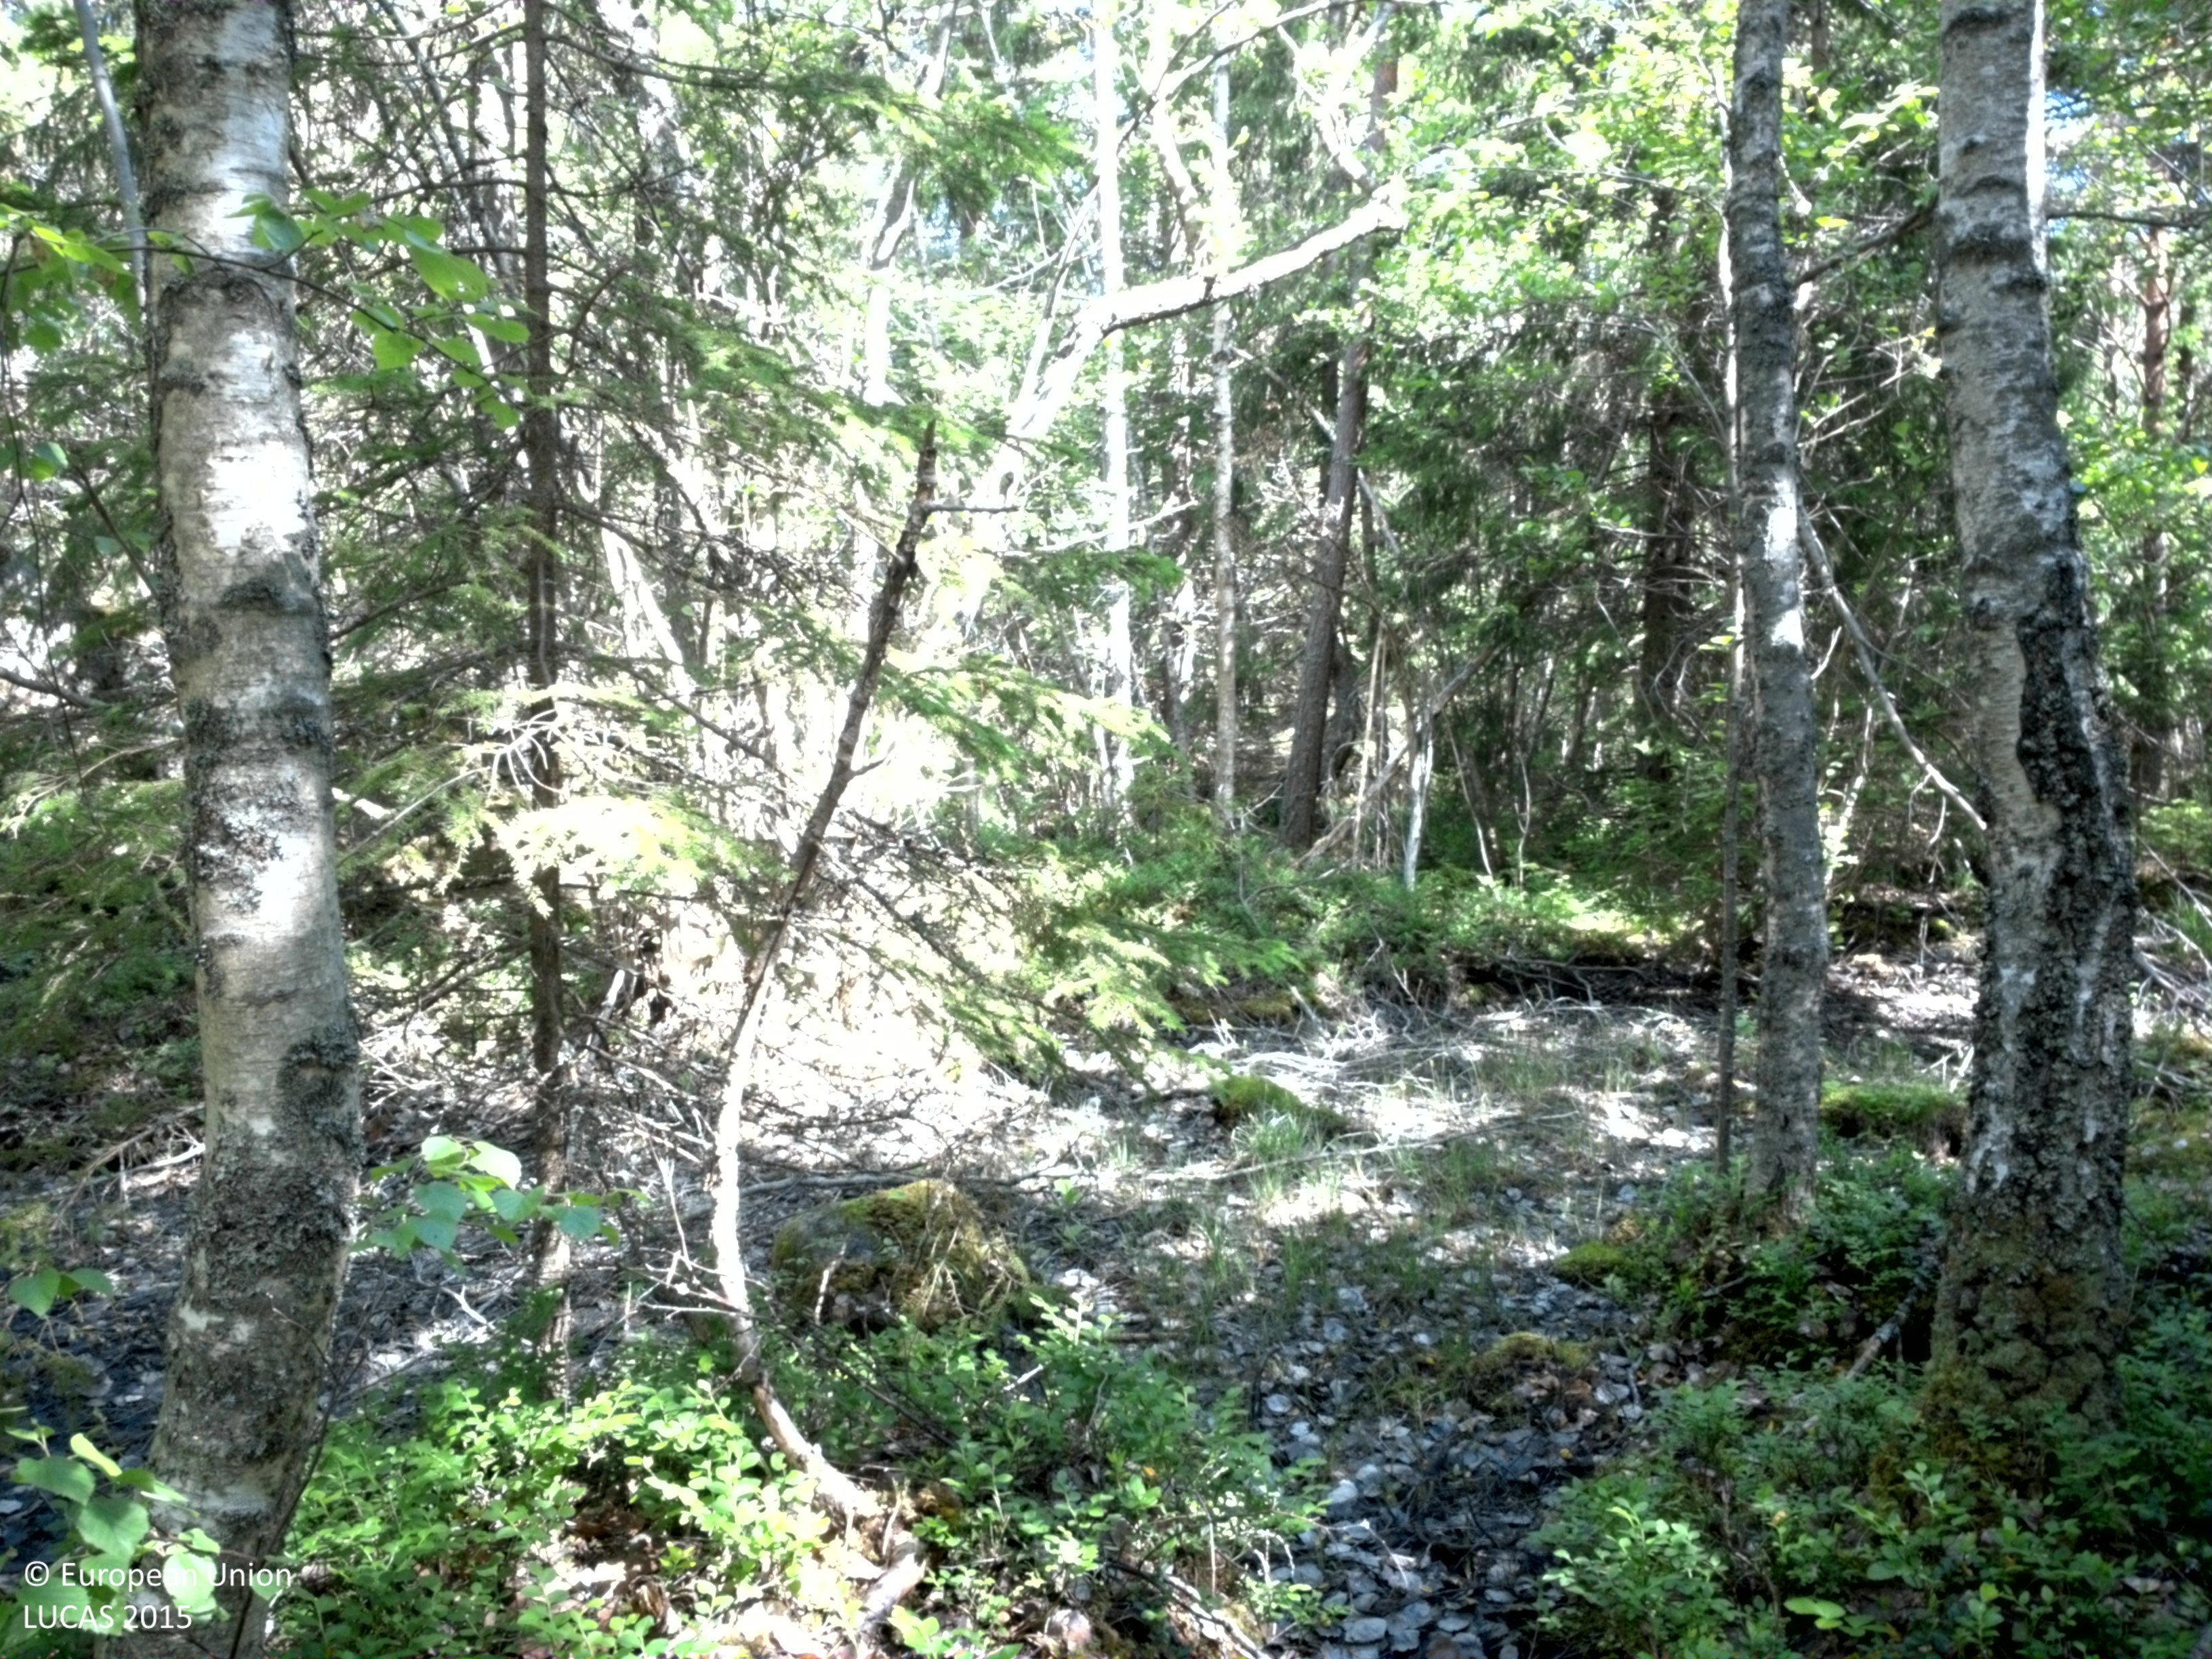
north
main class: Woodland
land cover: Spruce dominated mixed woodland
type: boreal forest
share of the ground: 50 - 75 %
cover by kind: coniferous forest trees 45 %, lichens and mosses 25 %, broadleaved forest trees 15 %, herbaceous plants 15 %
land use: Forestry
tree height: > 5 m
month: June
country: SE
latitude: 60.1140
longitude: 18.6521
